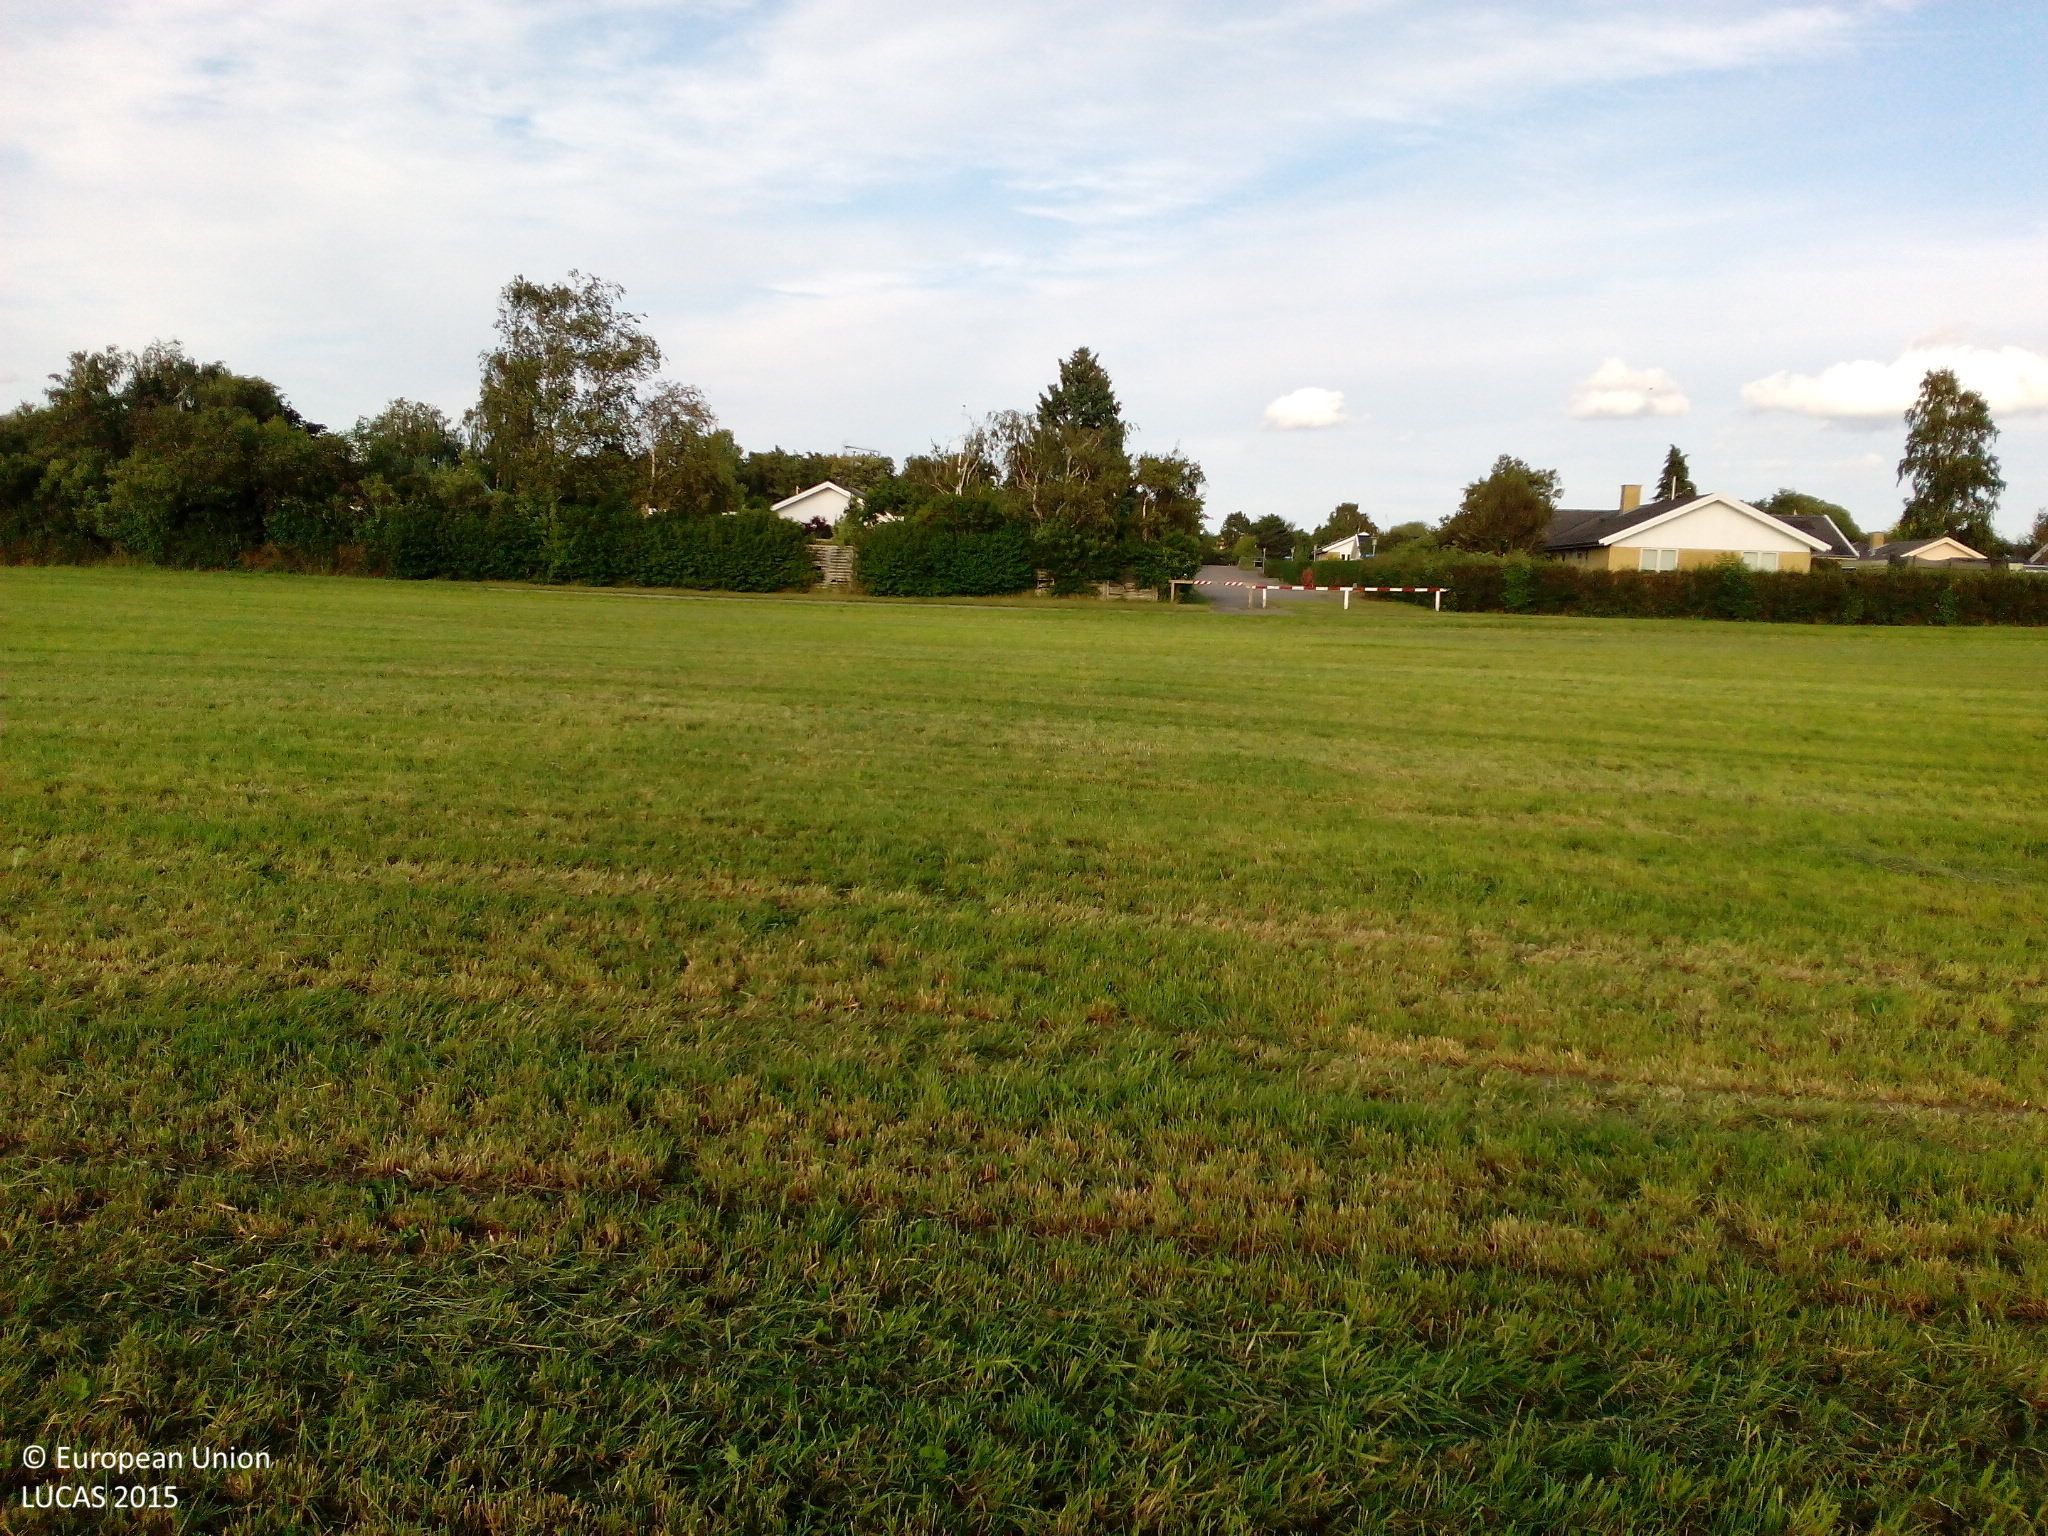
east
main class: Grassland
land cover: Grassland without tree/shrub cover
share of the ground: > 75 %
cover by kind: herbaceous plants 100 %
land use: Agriculture (excluding fallow land and kitchen gardens)
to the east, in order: Grassland without tree/shrub cover; Artificial constructions in urban areas
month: July
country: DK
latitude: 55.9358
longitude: 12.1591
